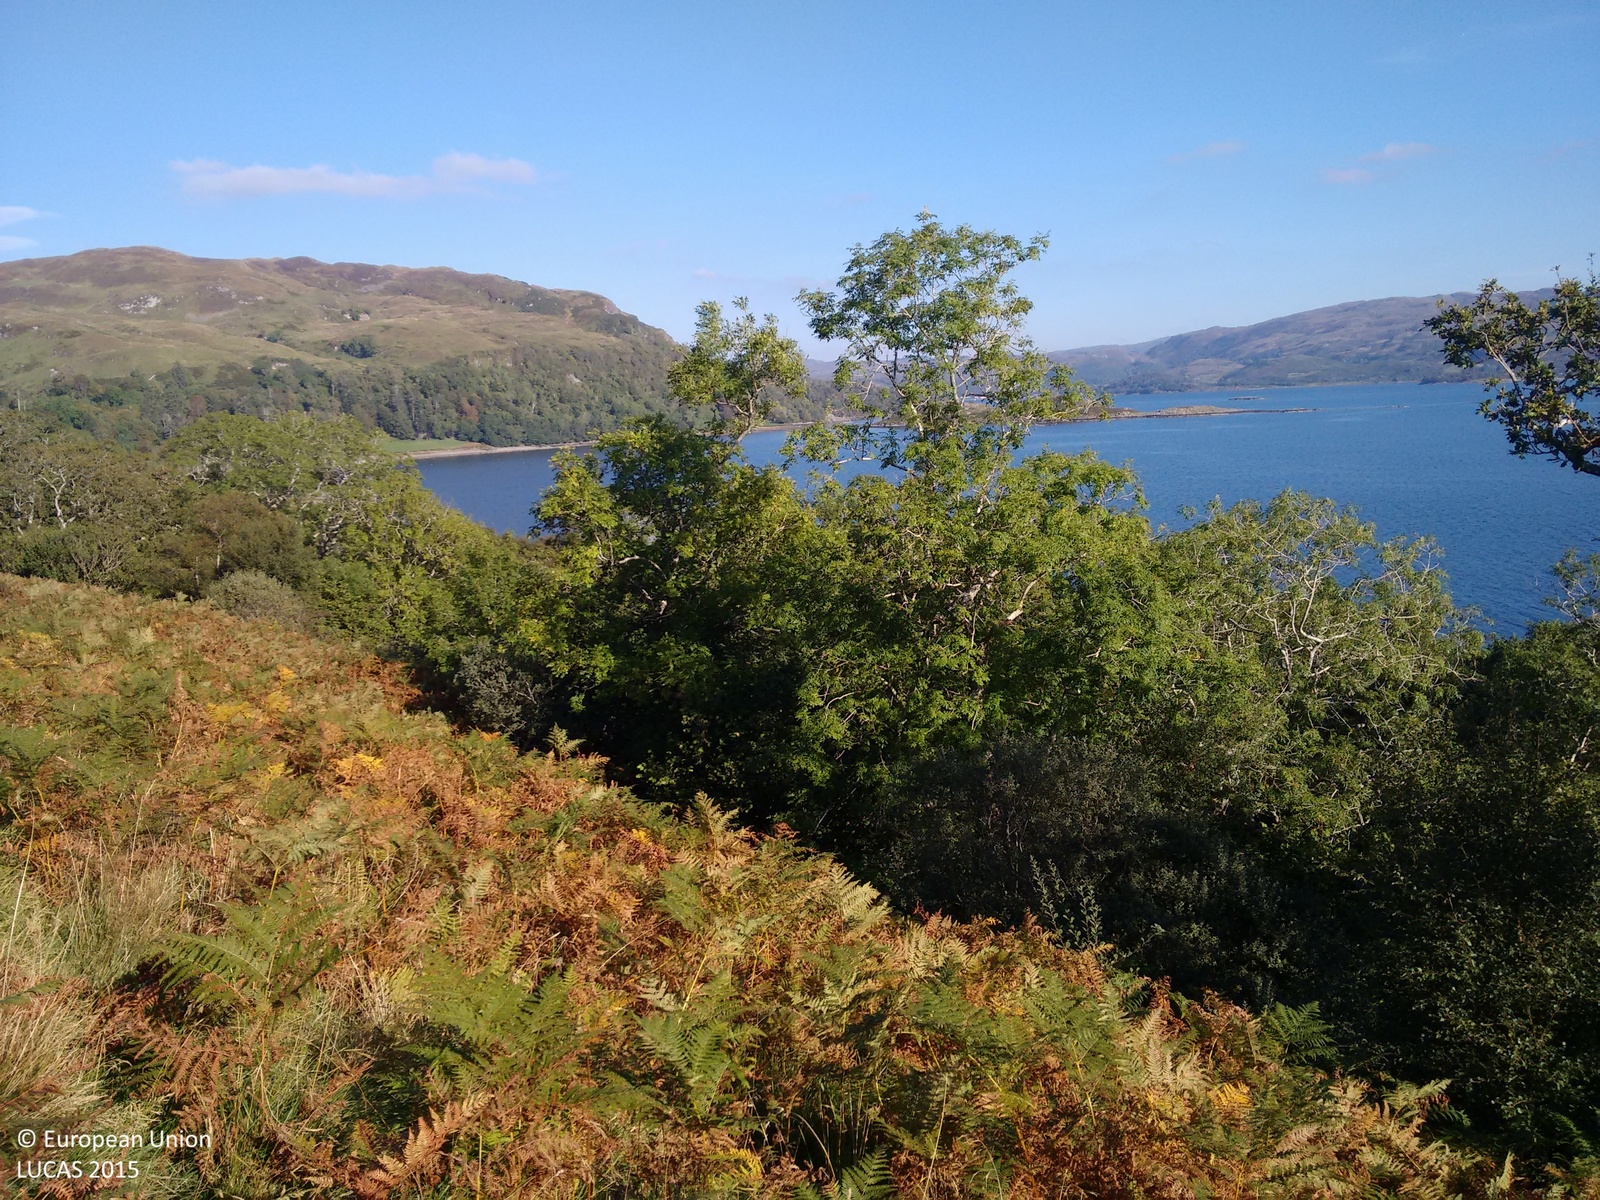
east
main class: Woodland
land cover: Broadleaved woodland
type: non-riverine alder, birch or aspen forest
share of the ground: > 75 %
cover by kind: broadleaved forest trees 95 %, shrubs 5 %
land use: Semi-natural and natural areas not in use
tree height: > 5 m
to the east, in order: Broadleaved woodland; Sand
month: August
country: GB
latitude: 56.2565
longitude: -5.5710
